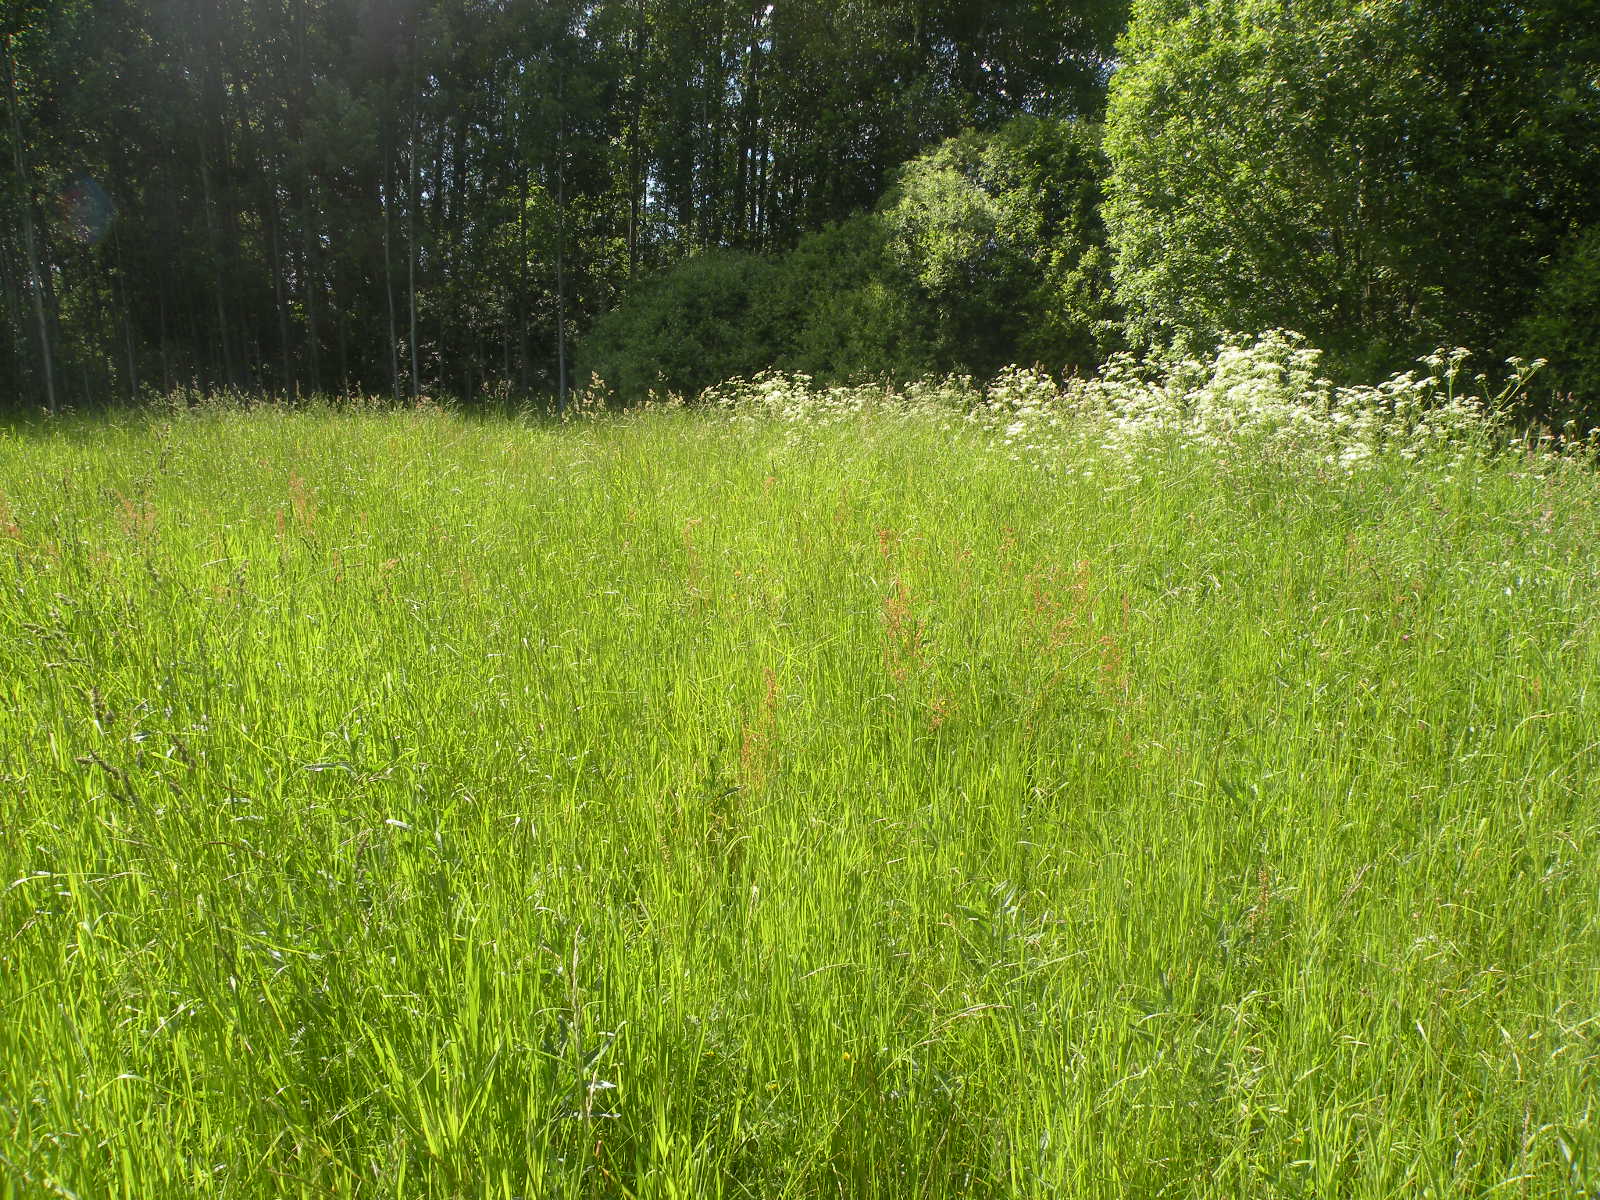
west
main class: Grassland
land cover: Grassland without tree/shrub cover
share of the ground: > 75 %
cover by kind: herbaceous plants 100 %
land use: Agriculture (excluding fallow land and kitchen gardens)
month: June
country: LV
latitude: 55.9297
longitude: 26.6900
